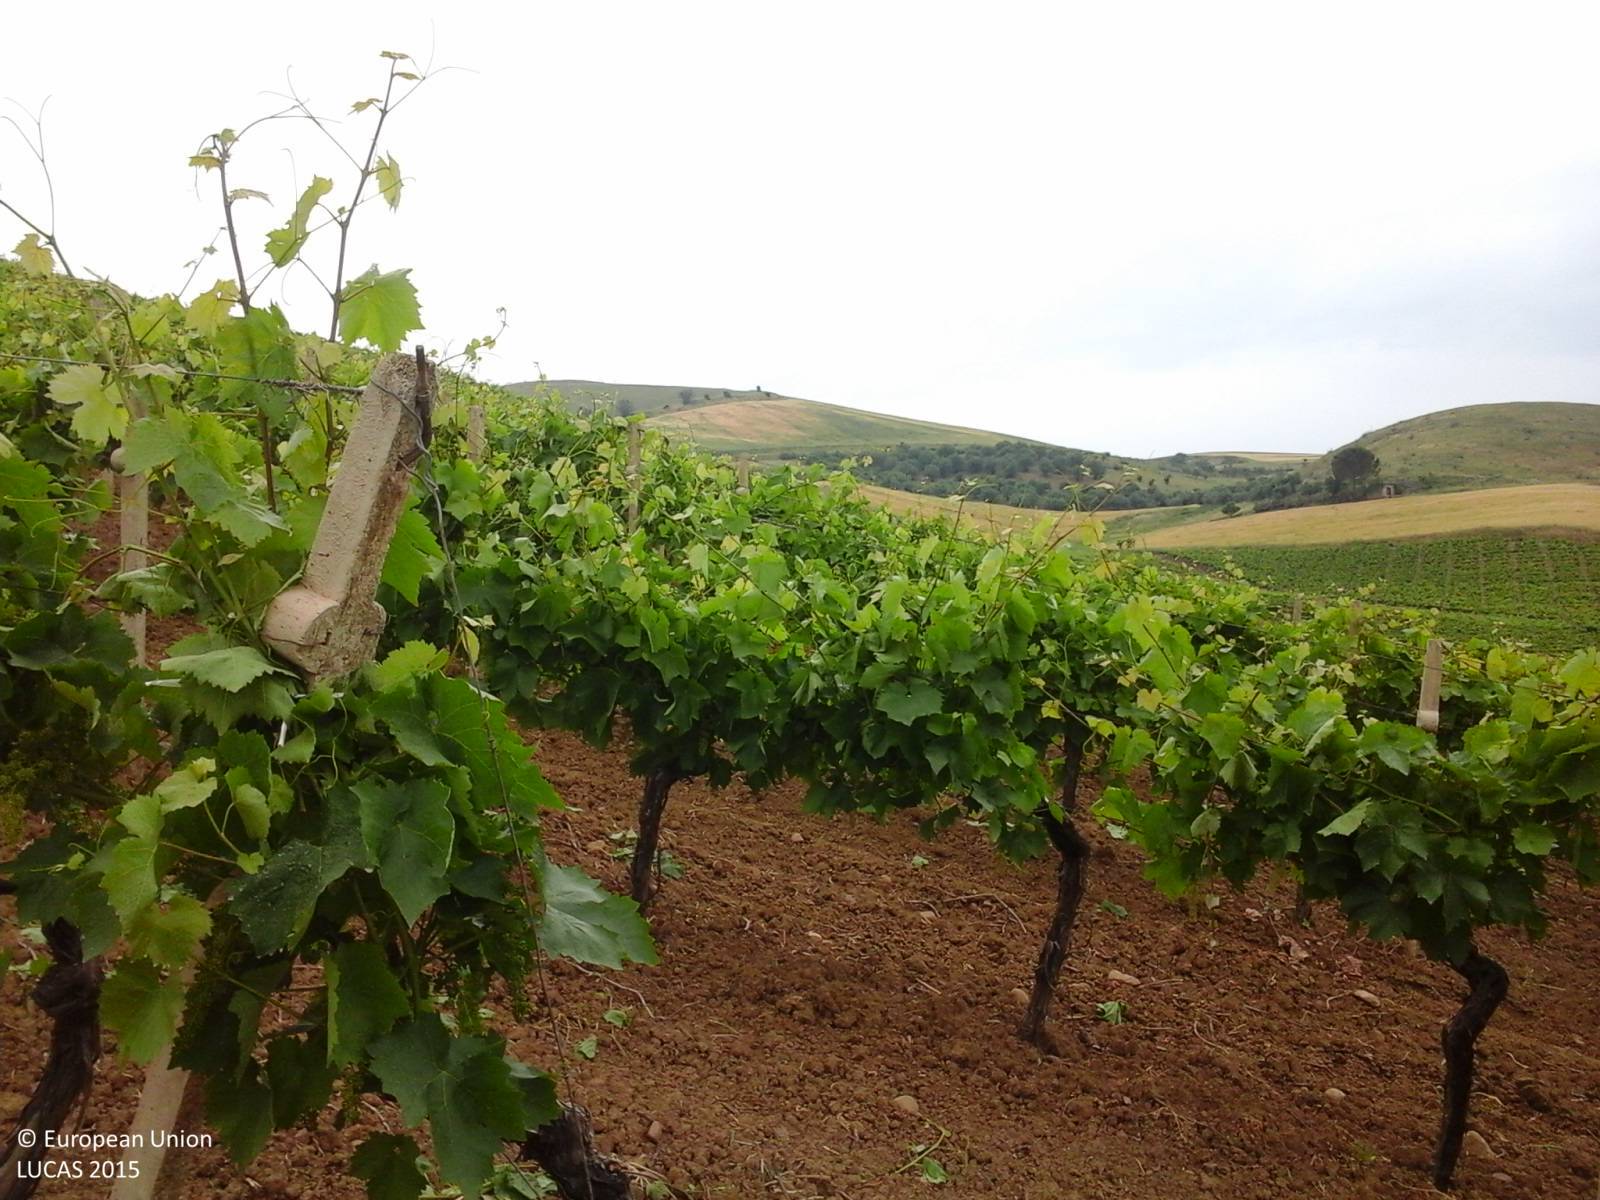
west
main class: Cropland
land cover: Vineyards
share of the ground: 50 - 75 %
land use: Agriculture (excluding fallow land and kitchen gardens)
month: June
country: IT
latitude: 37.9118
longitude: 13.1958
